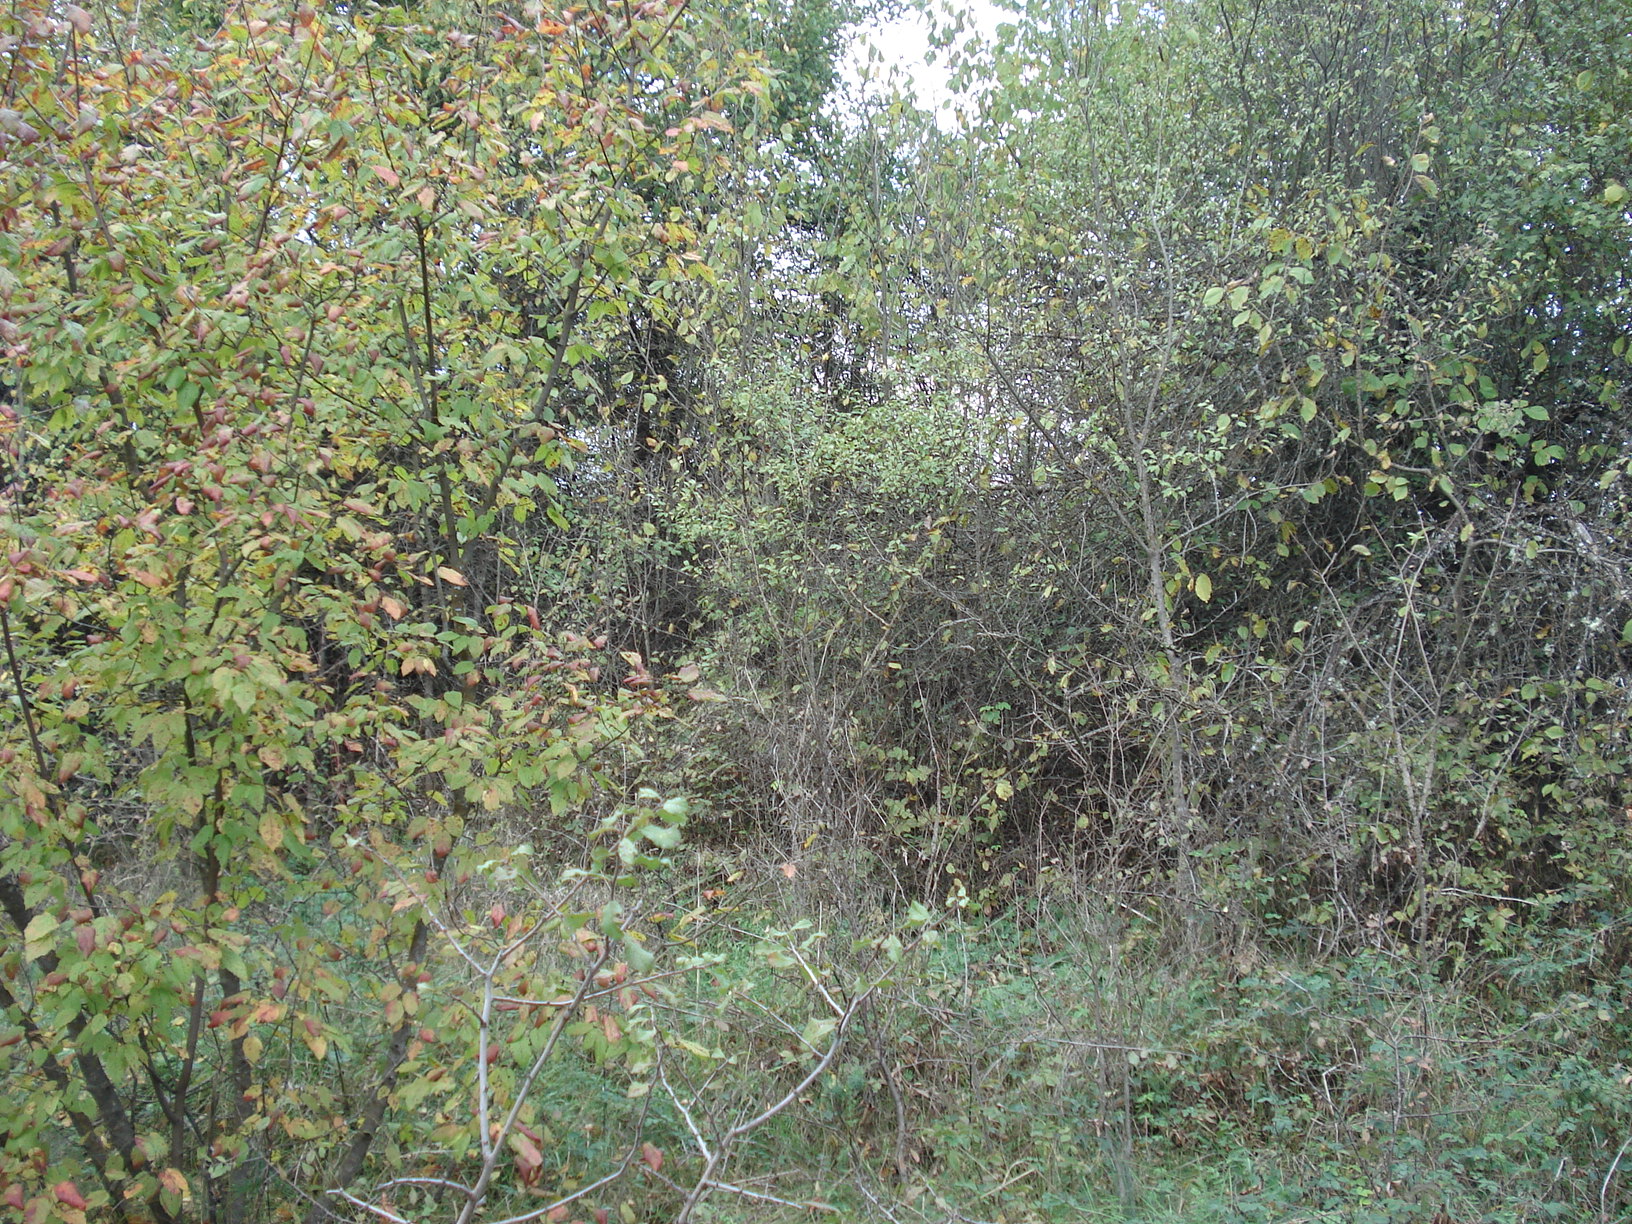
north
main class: Woodland
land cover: Broadleaved woodland
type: mesophytic deciduous forest
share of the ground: 50 - 75 %
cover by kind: broadleaved forest trees 60 %, herbaceous plants 30 %, shrubs 10 %
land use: Forestry
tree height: > 5 m
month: October
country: BG
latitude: 42.9632
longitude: 26.1623
